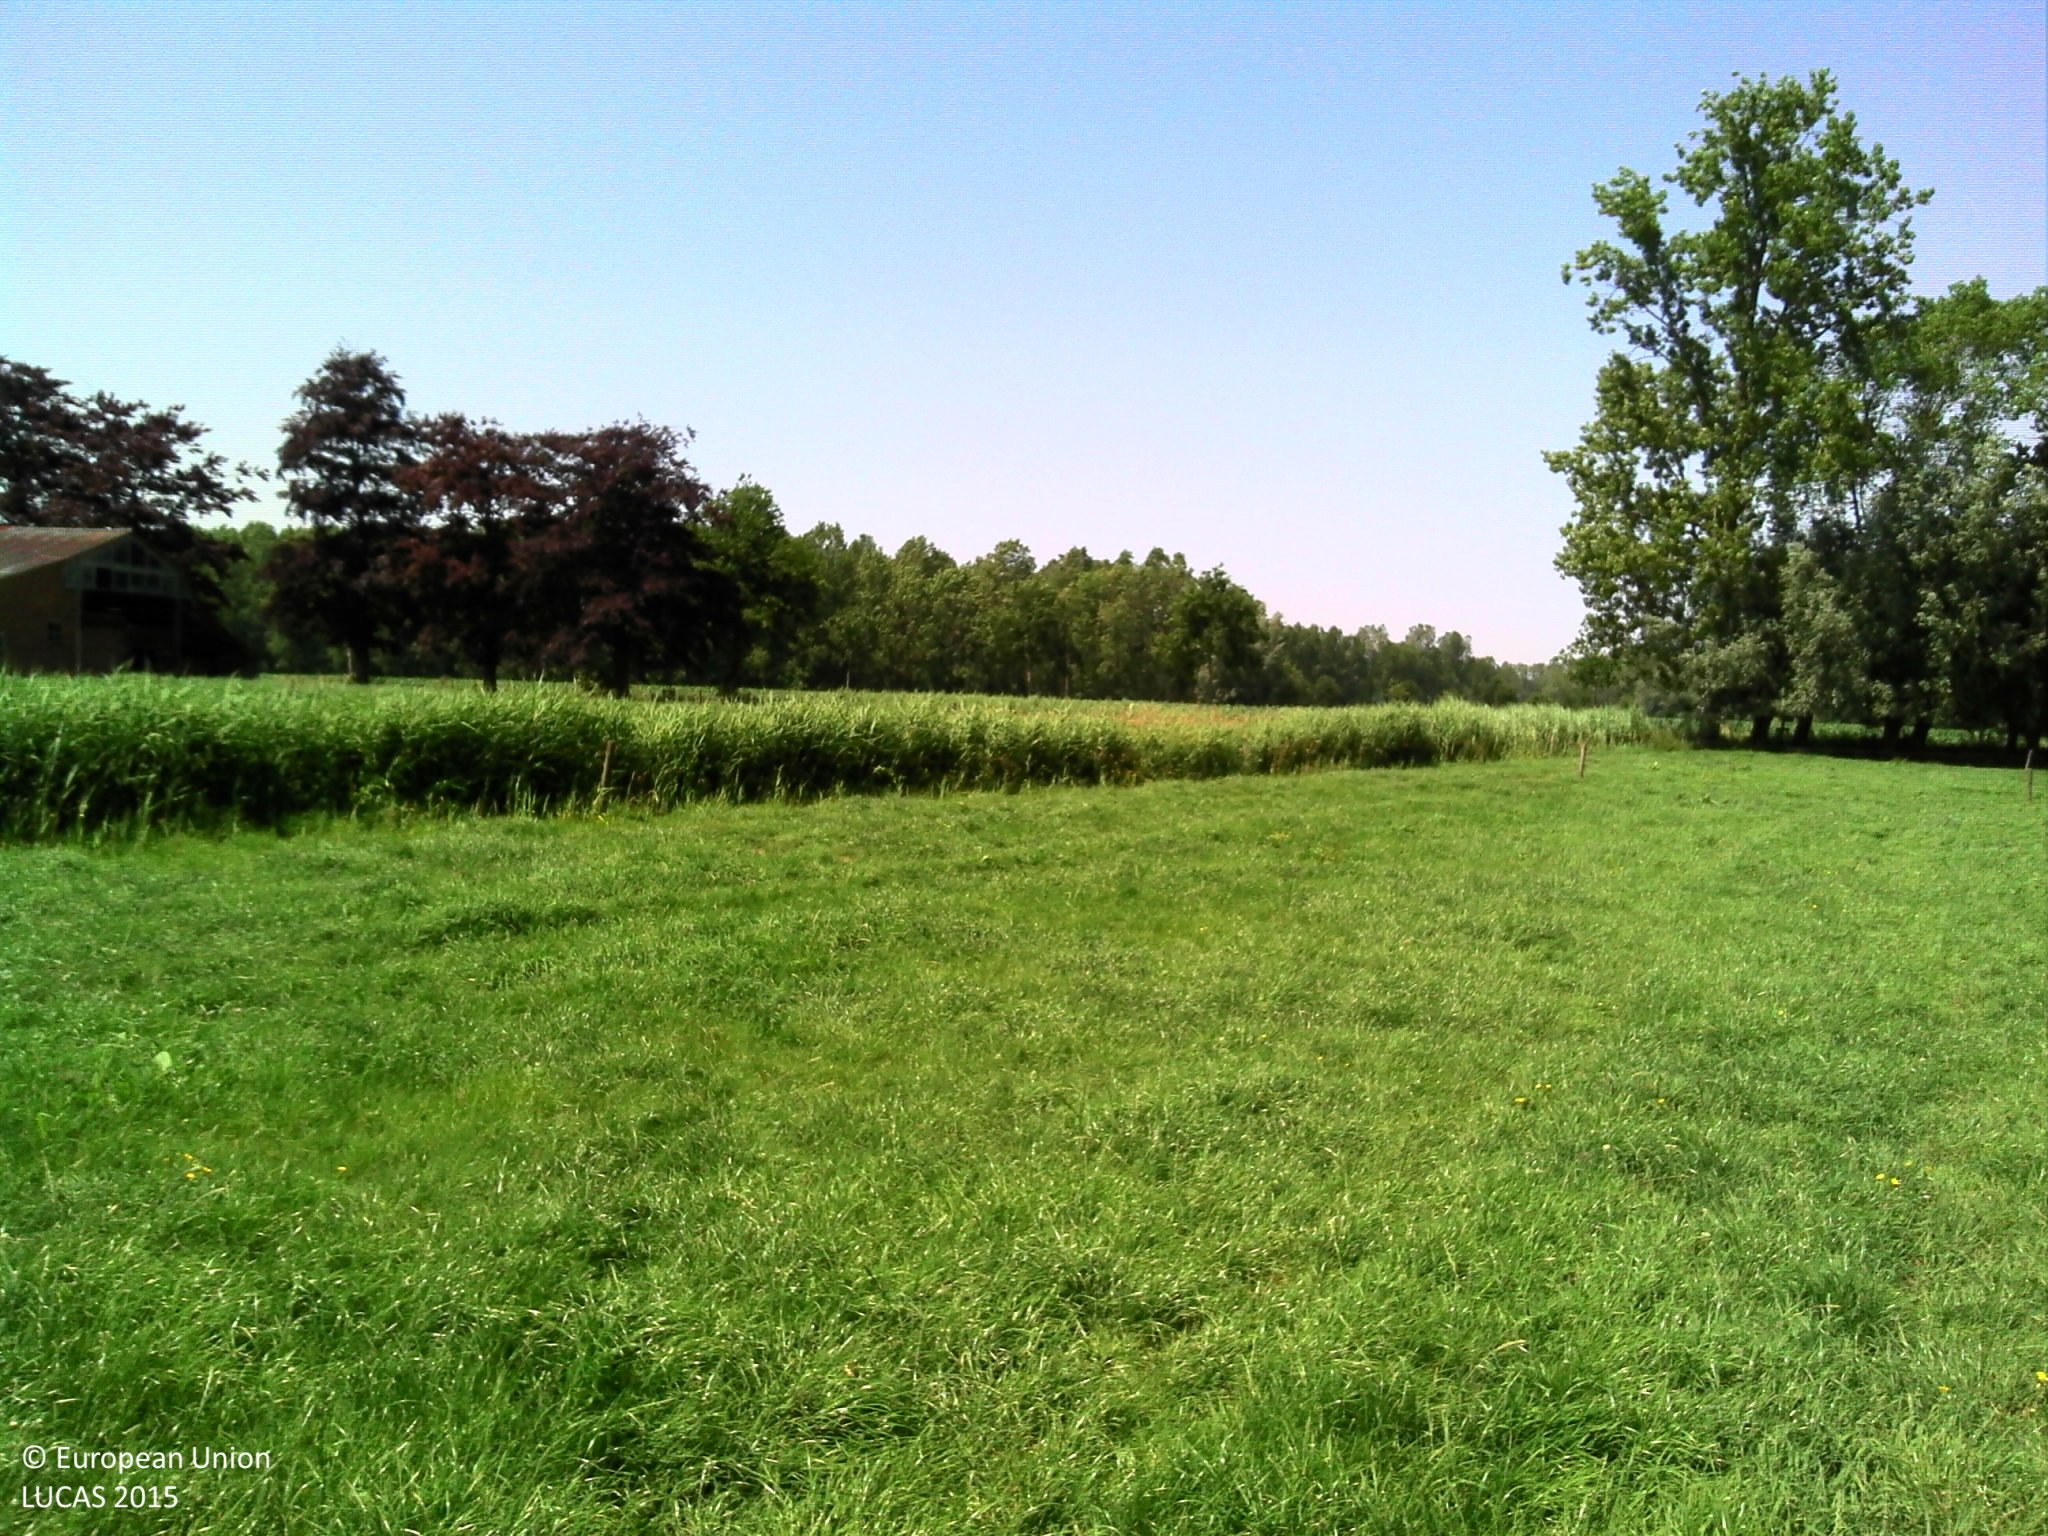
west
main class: Grassland
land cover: Grassland without tree/shrub cover
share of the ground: > 75 %
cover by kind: herbaceous plants 100 %
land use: Agriculture (excluding fallow land and kitchen gardens)
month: July
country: BE
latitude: 51.1672
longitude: 3.4276
